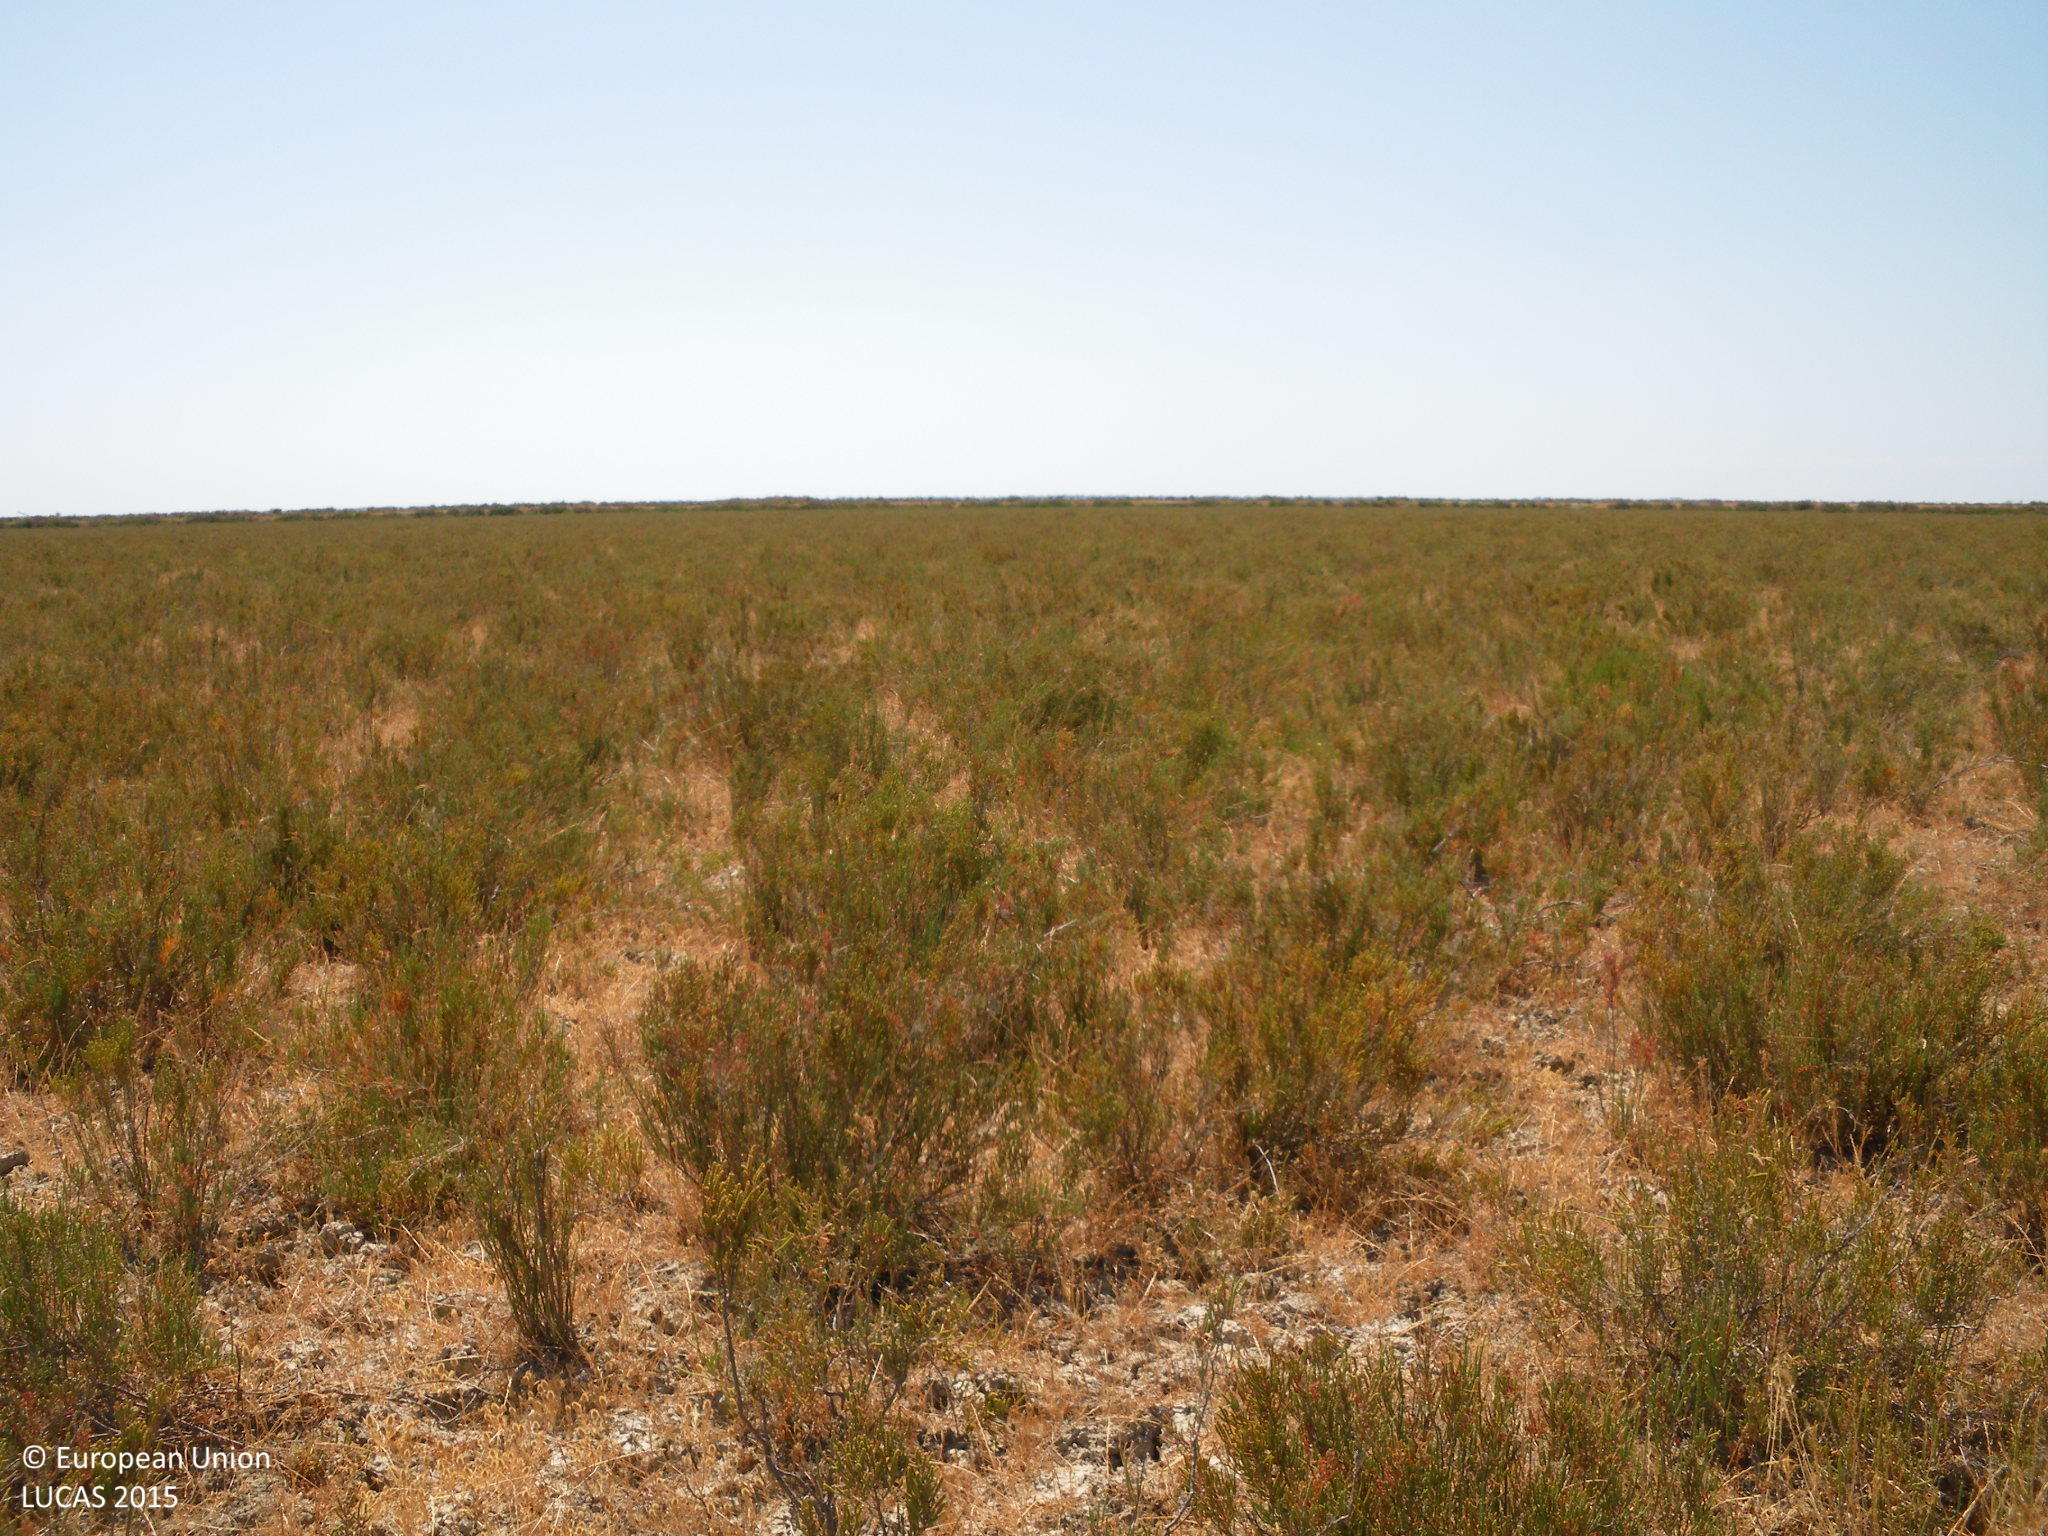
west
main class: Shrubland
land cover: Shrubland without tree cover
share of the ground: 50 - 75 %
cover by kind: shrubs 50 %, herbaceous plants 35 %, unconsolidated bare surface 15 %
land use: Agriculture (excluding fallow land and kitchen gardens)
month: May
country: ES
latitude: 36.8846
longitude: -6.2993
